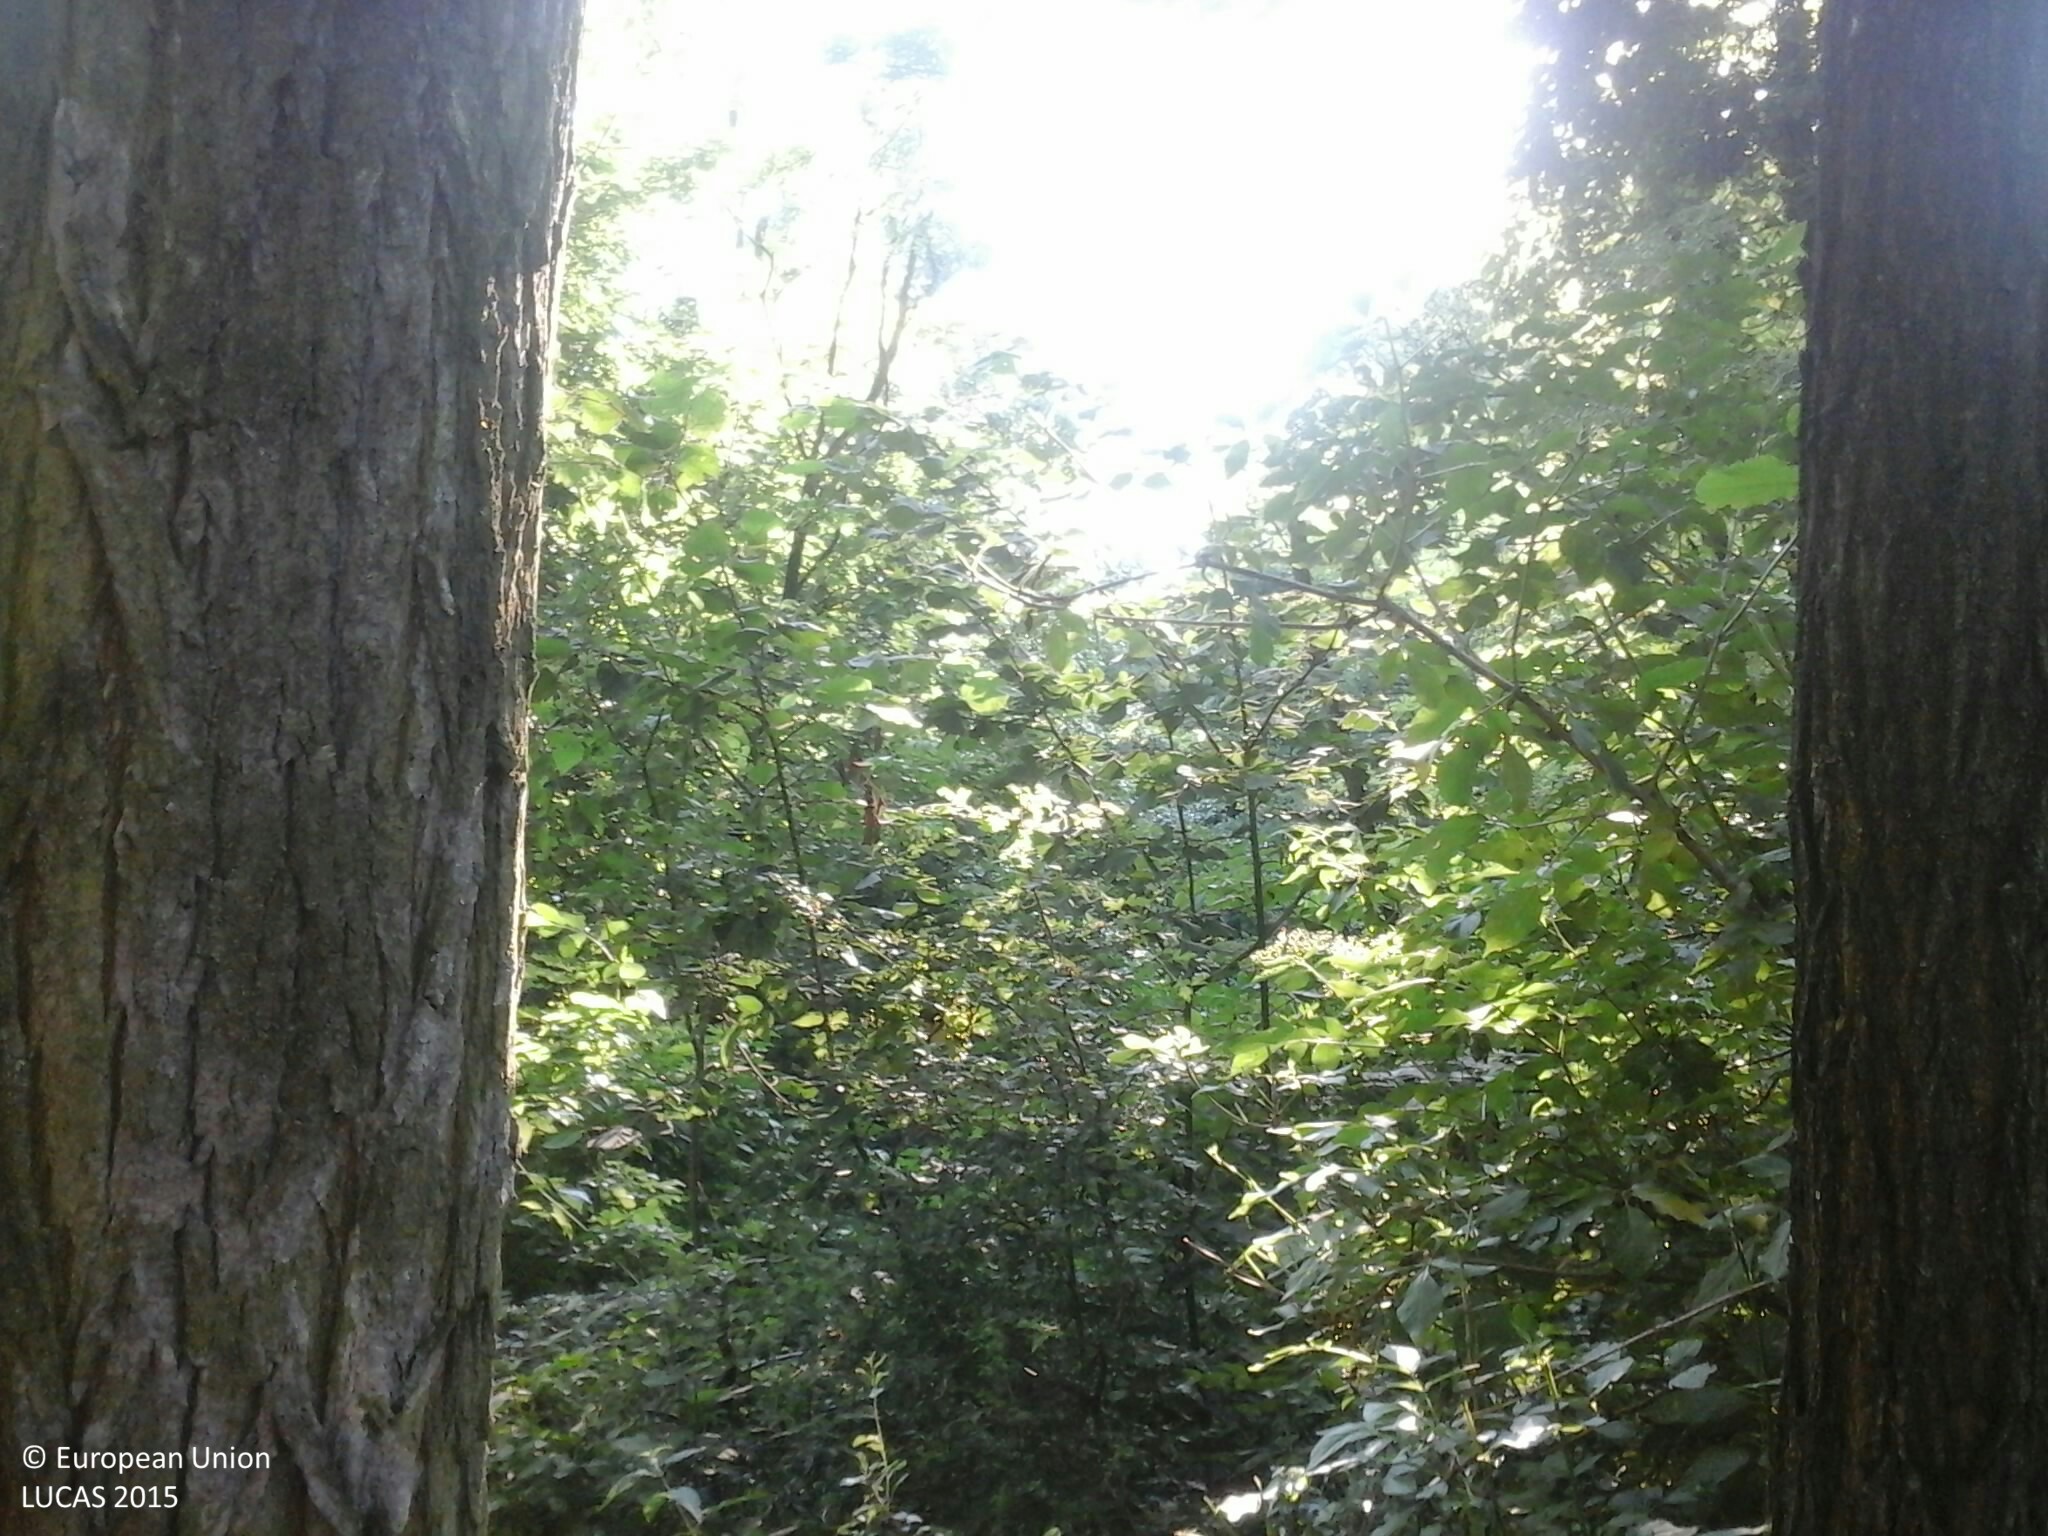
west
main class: Woodland
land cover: Broadleaved woodland
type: exotic forest
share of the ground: > 75 %
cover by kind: broadleaved forest trees 90 %, shrubs 10 %
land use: Forestry
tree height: > 5 m
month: July
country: HU
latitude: 47.3659
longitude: 17.8352
